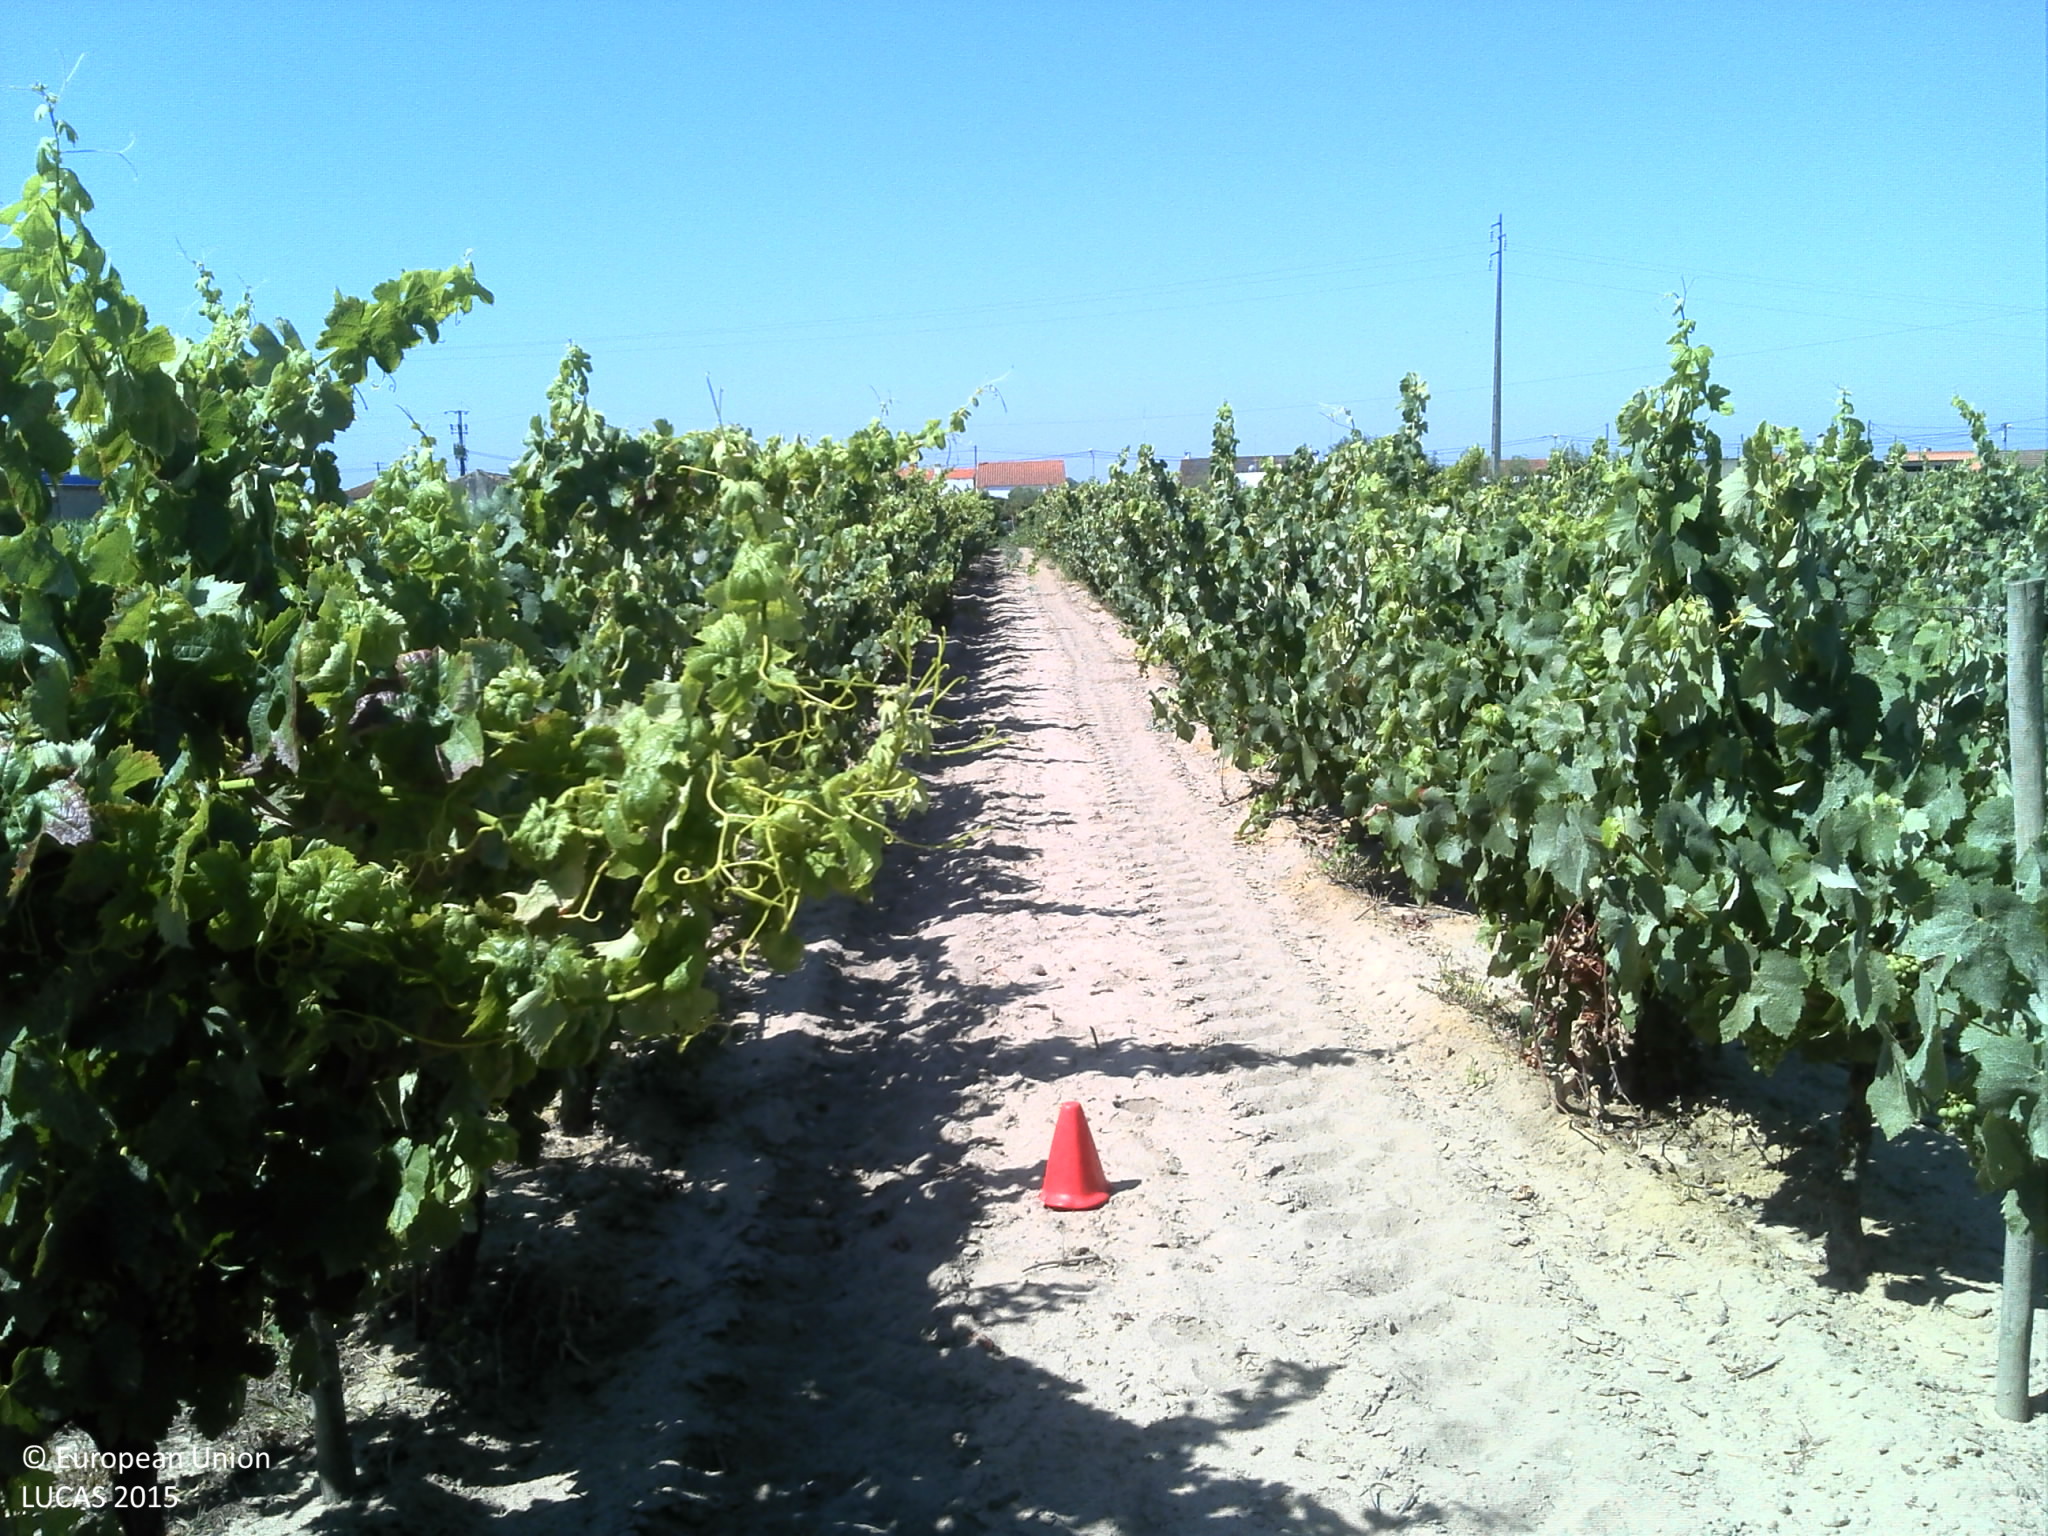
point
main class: Cropland
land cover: Vineyards
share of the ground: 25 - 50 %
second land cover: Other bare soil
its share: > 75 %
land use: Agriculture (excluding fallow land and kitchen gardens)
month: June
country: PT
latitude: 39.1258
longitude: -8.6582
